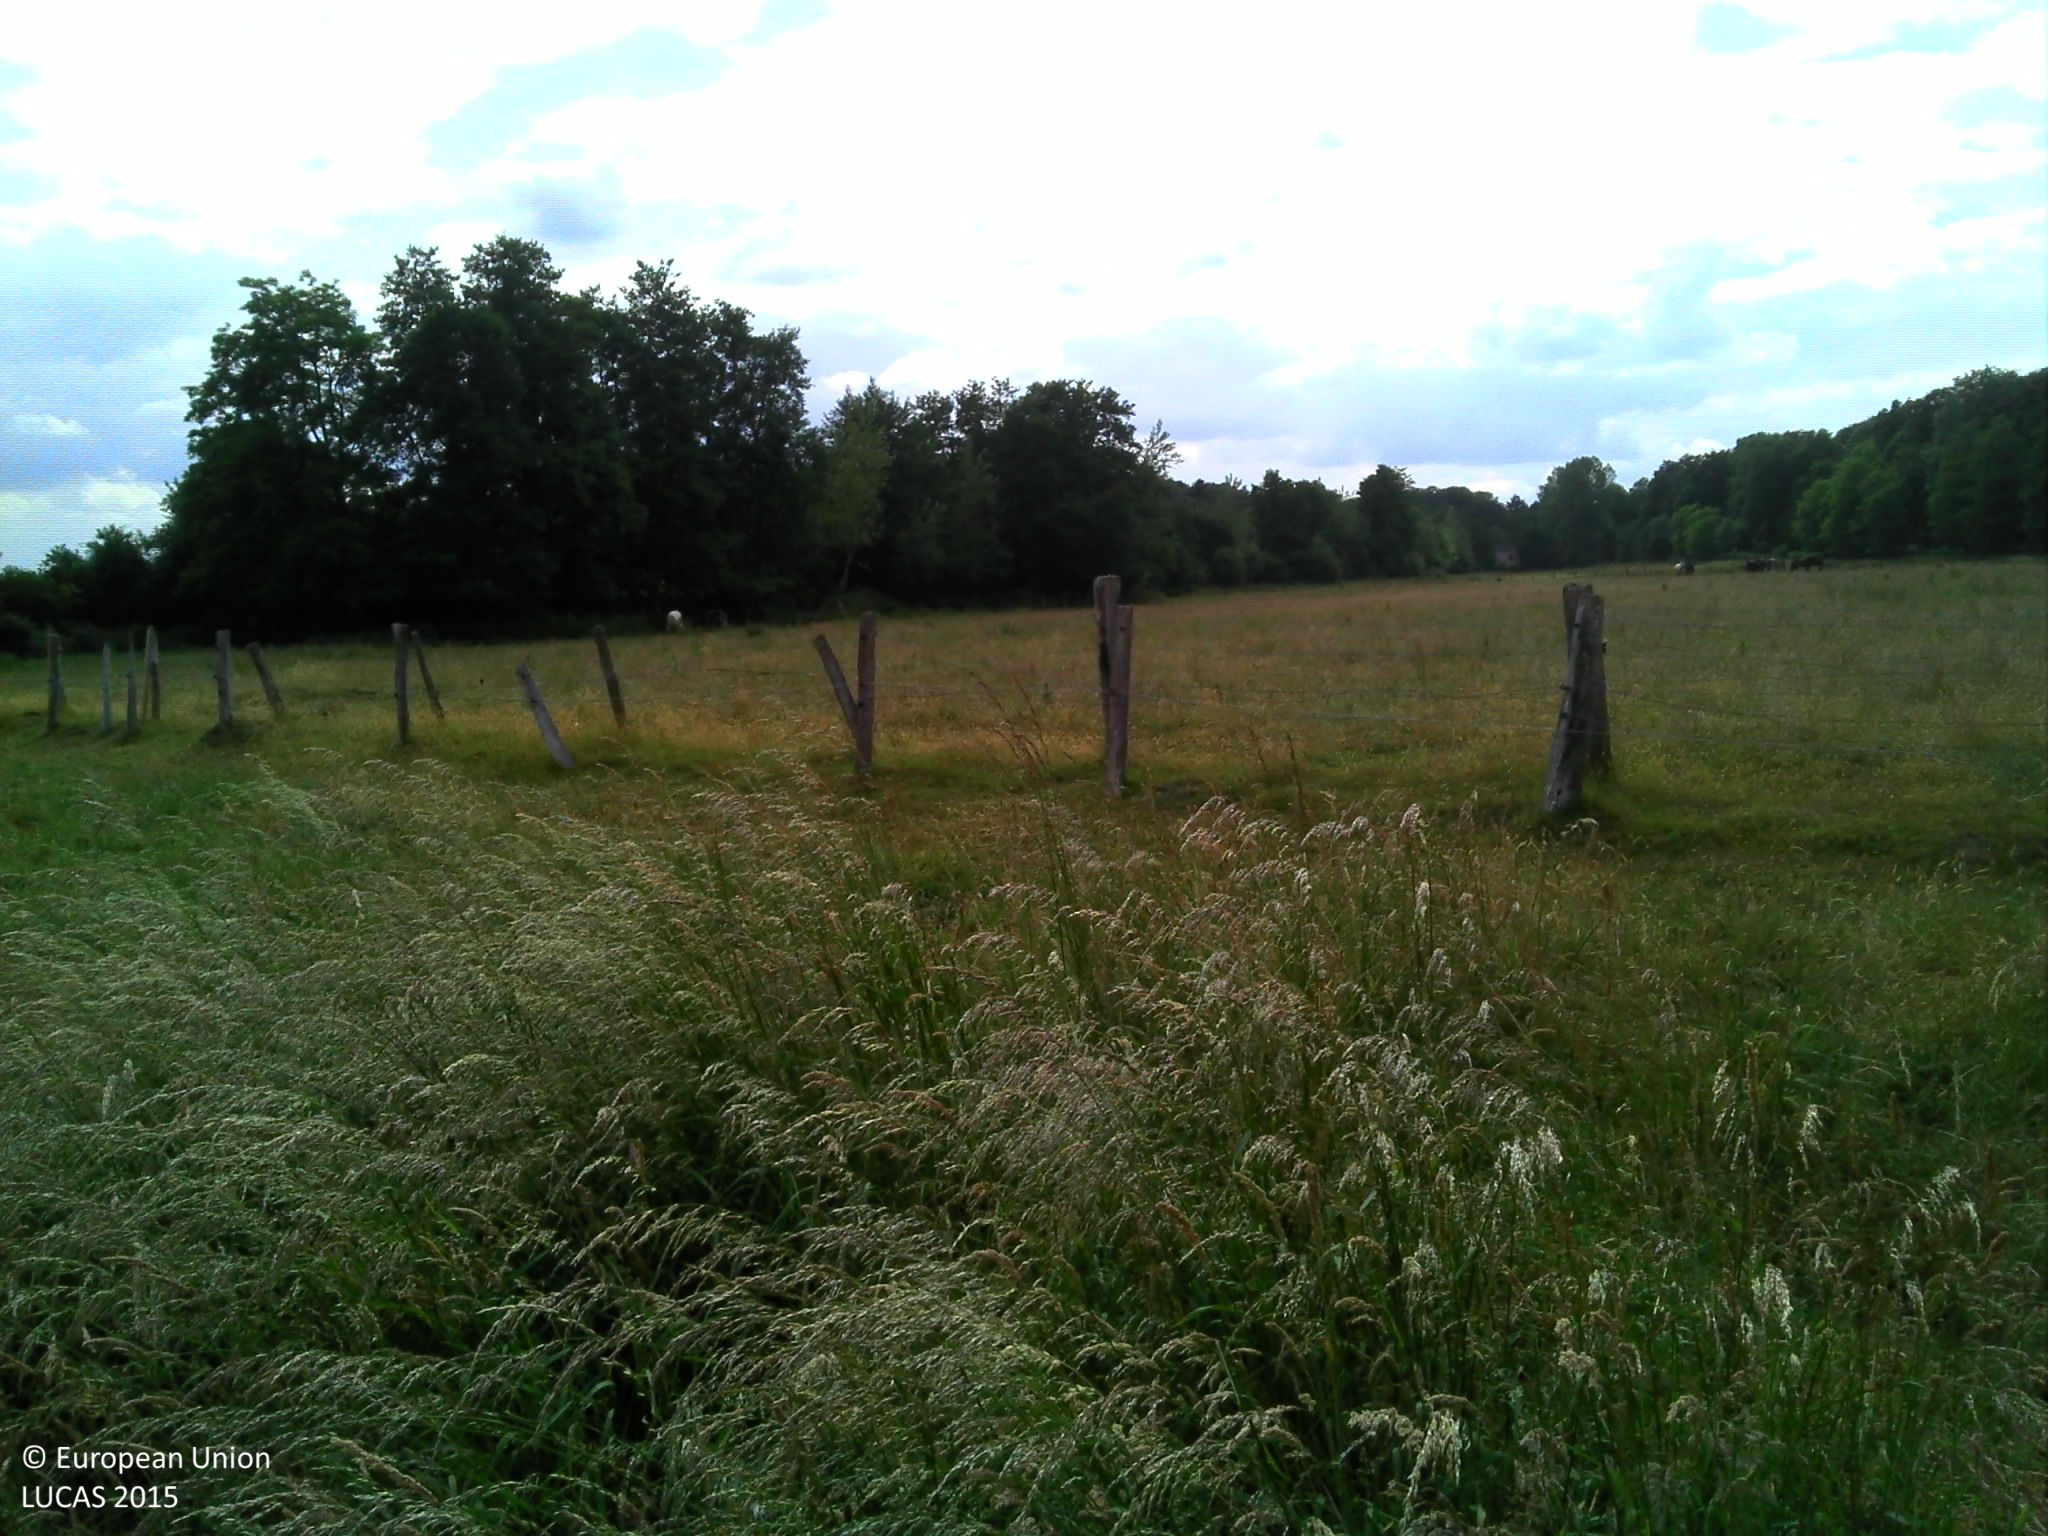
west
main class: Grassland
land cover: Grassland without tree/shrub cover
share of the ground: > 75 %
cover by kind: herbaceous plants 100 %
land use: Agriculture (excluding fallow land and kitchen gardens)
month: June
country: BE
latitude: 50.4908
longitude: 3.9187
